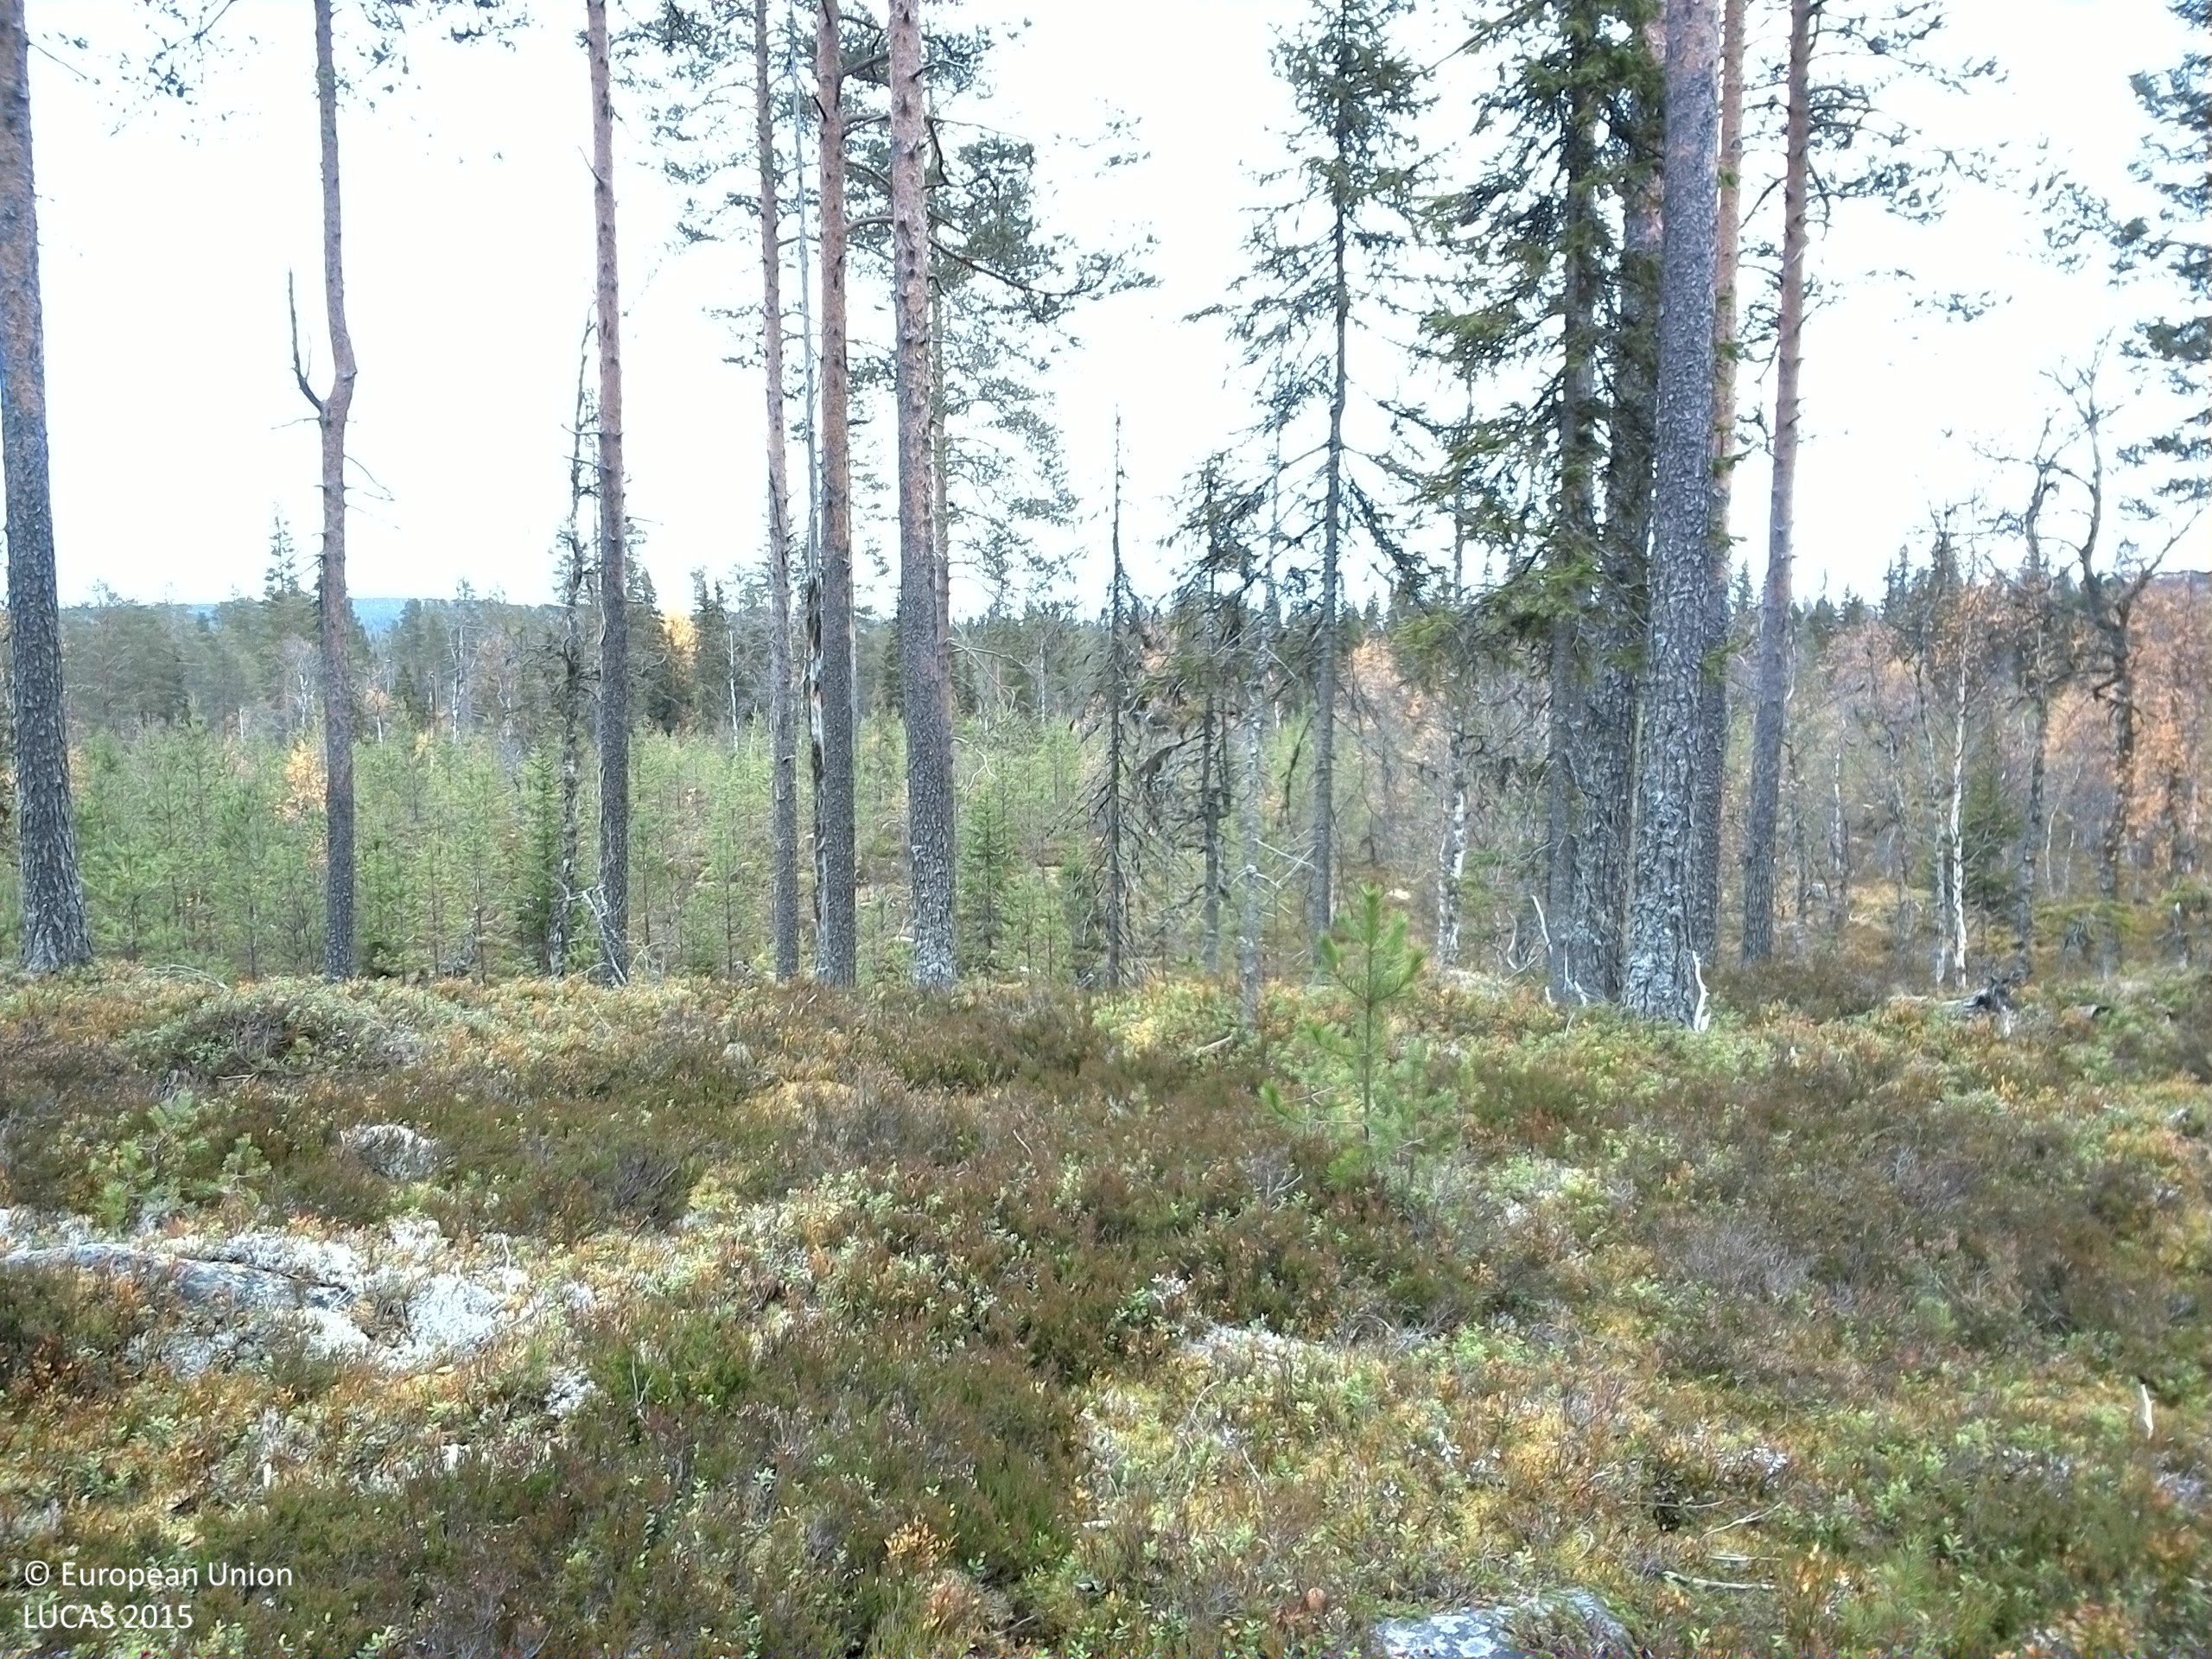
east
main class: Woodland
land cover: Pine dominated coniferous woodland
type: boreal forest
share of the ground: 25 - 50 %
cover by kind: shrubs 45 %, coniferous forest trees 35 %, lichens and mosses 20 %
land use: Forestry
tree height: > 5 m
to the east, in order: Pine dominated coniferous woodland; Pine dominated mixed woodland; Paved roads, cycling and walking lanes; Other coniferous woodland; Spruce dominated coniferous woodland; Inland fresh water bodies
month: October
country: SE
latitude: 61.5201
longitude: 14.3654
